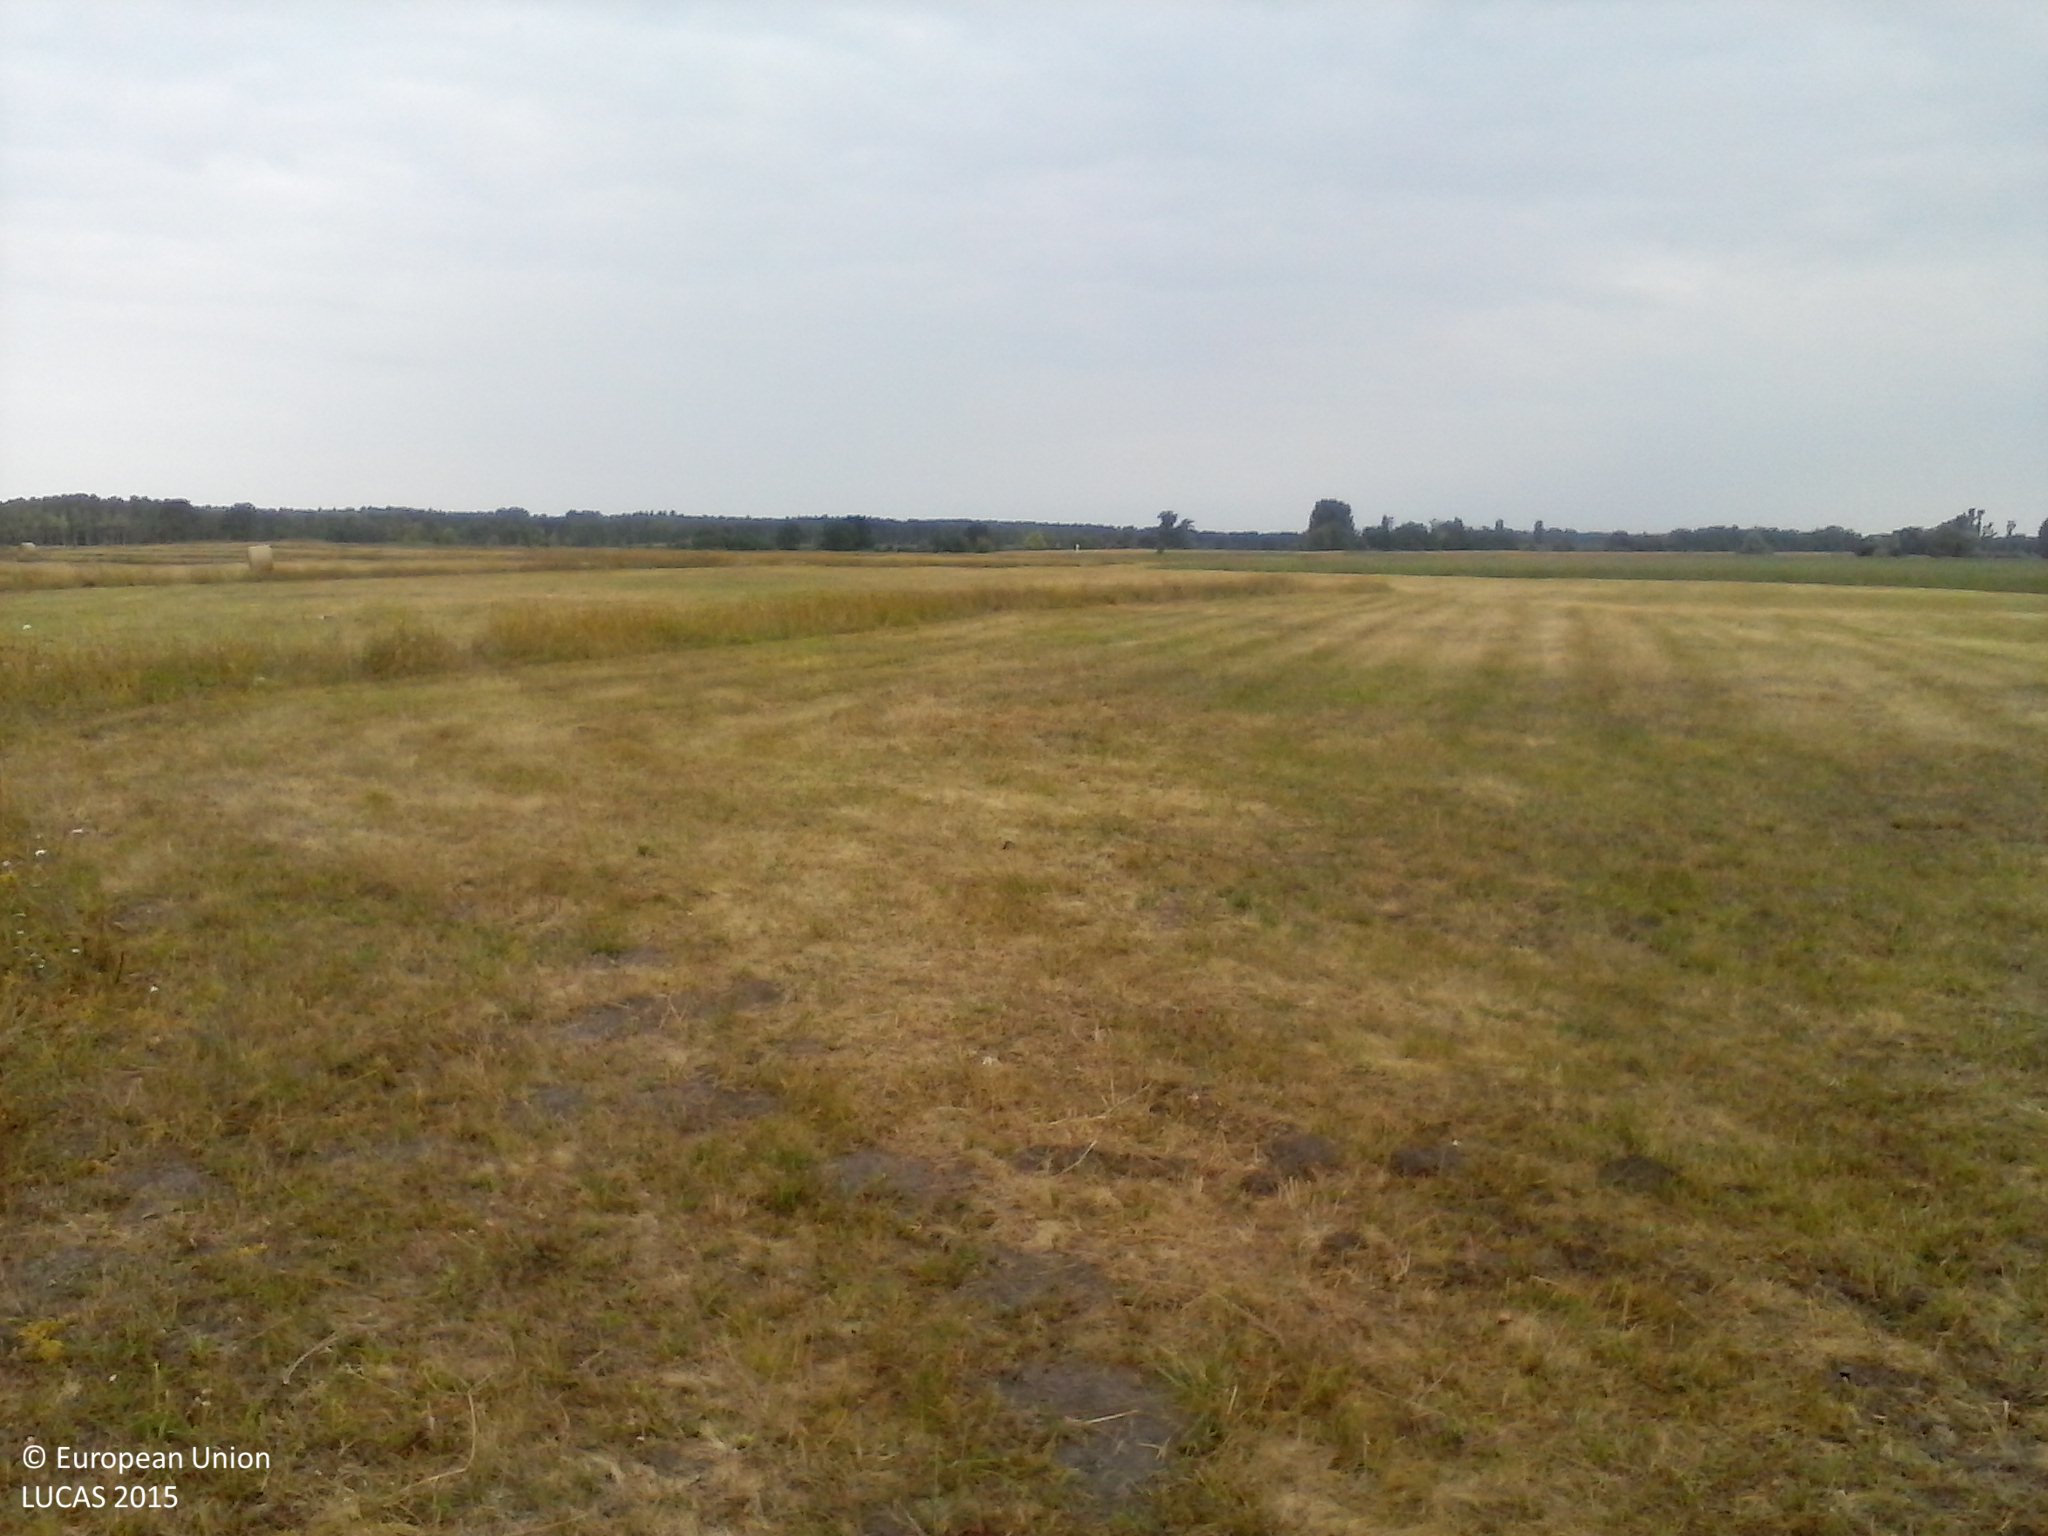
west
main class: Grassland
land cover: Grassland without tree/shrub cover
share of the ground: > 75 %
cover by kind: herbaceous plants 100 %
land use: Agriculture (excluding fallow land and kitchen gardens)
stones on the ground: < 10 %
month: July
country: HU
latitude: 46.4836
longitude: 19.5662
